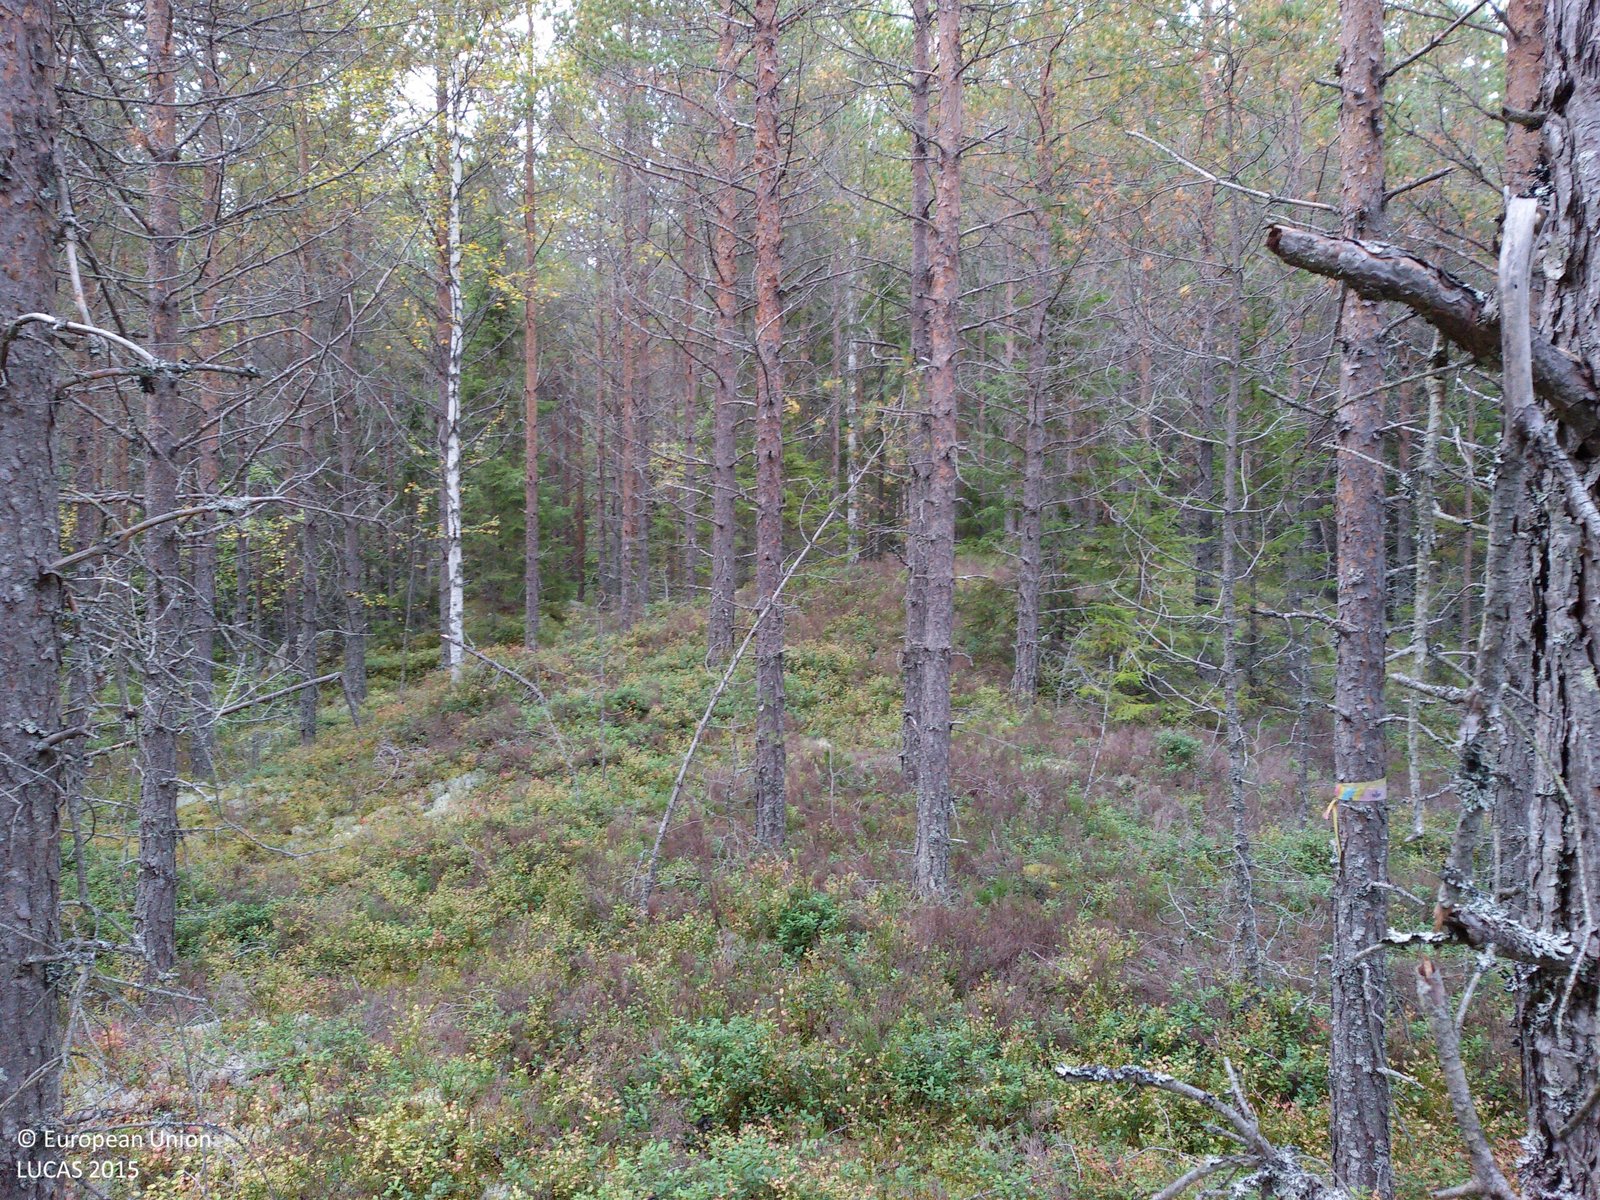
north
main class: Woodland
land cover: Pine dominated coniferous woodland
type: boreal forest
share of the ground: > 75 %
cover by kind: coniferous forest trees 80 %, shrubs 10 %, lichens and mosses 10 %
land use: Forestry
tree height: > 5 m
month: September
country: SE
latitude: 60.7182
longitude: 14.6246
